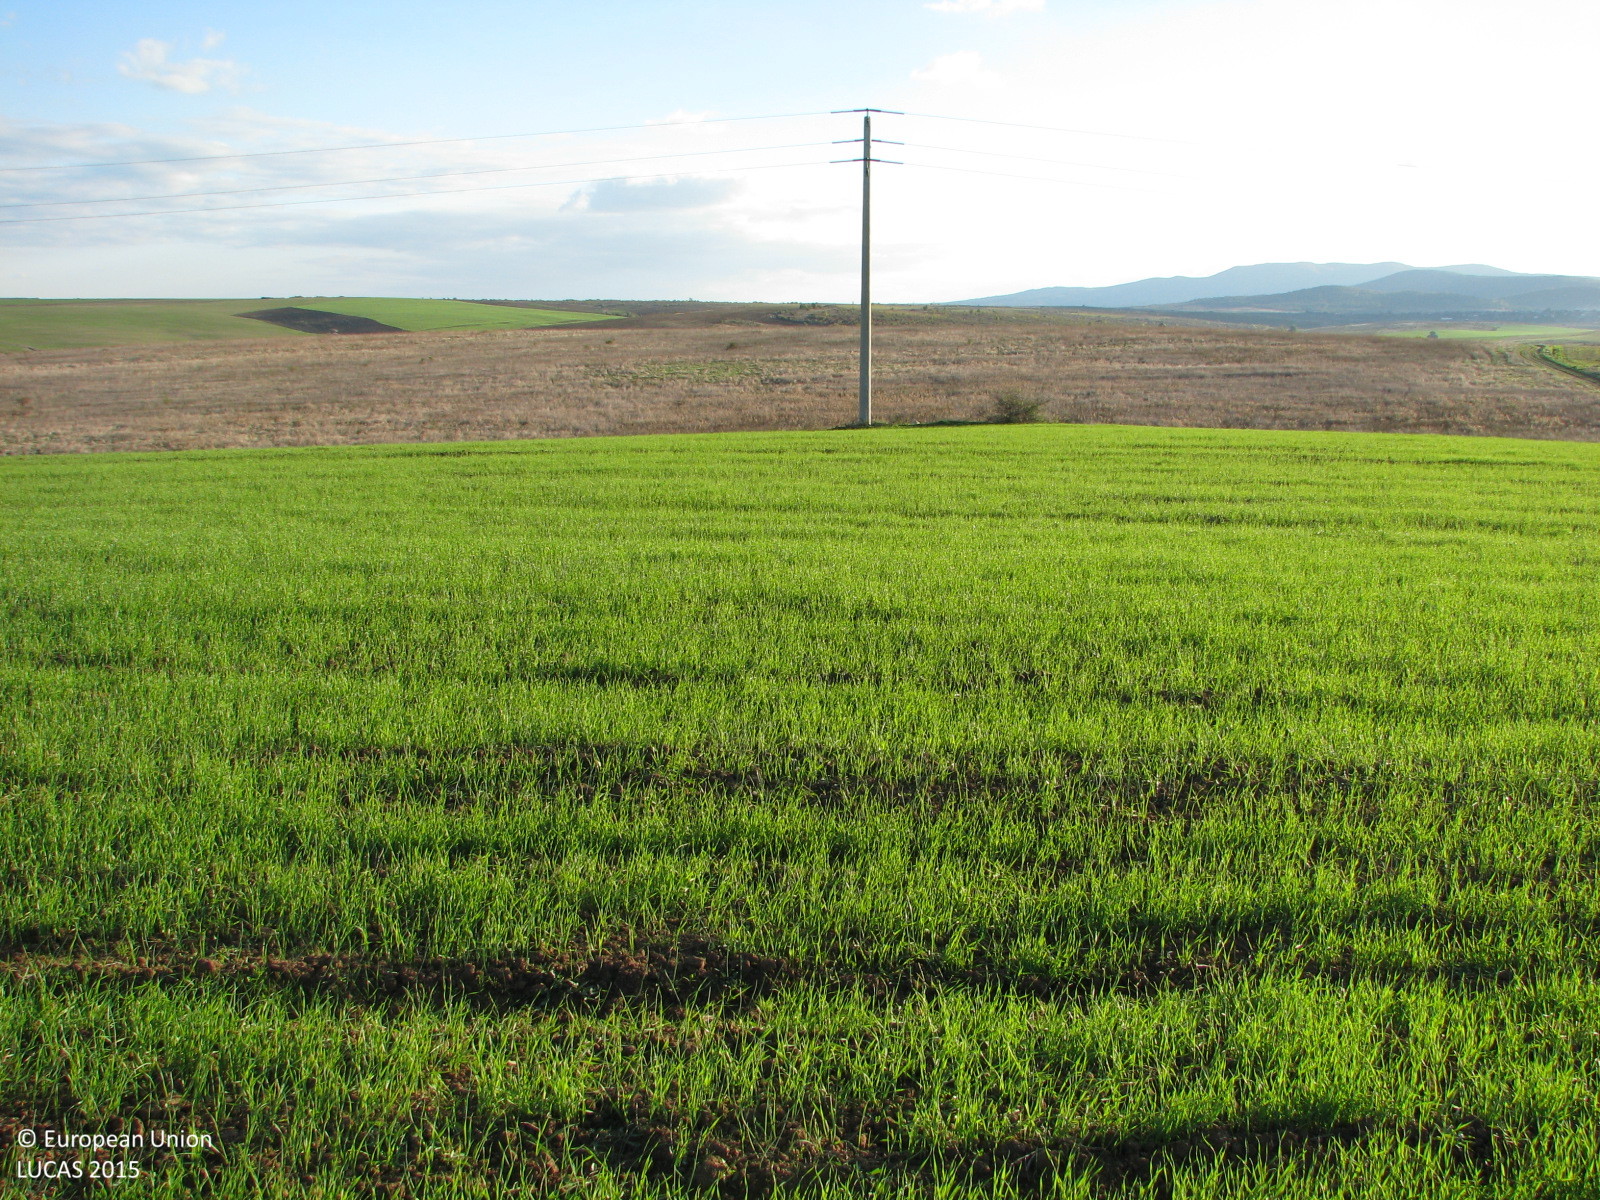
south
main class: Cropland
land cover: Common wheat
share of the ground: 50 - 75 %
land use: Agriculture (excluding fallow land and kitchen gardens)
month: October
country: BG
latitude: 42.1157
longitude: 26.4007
